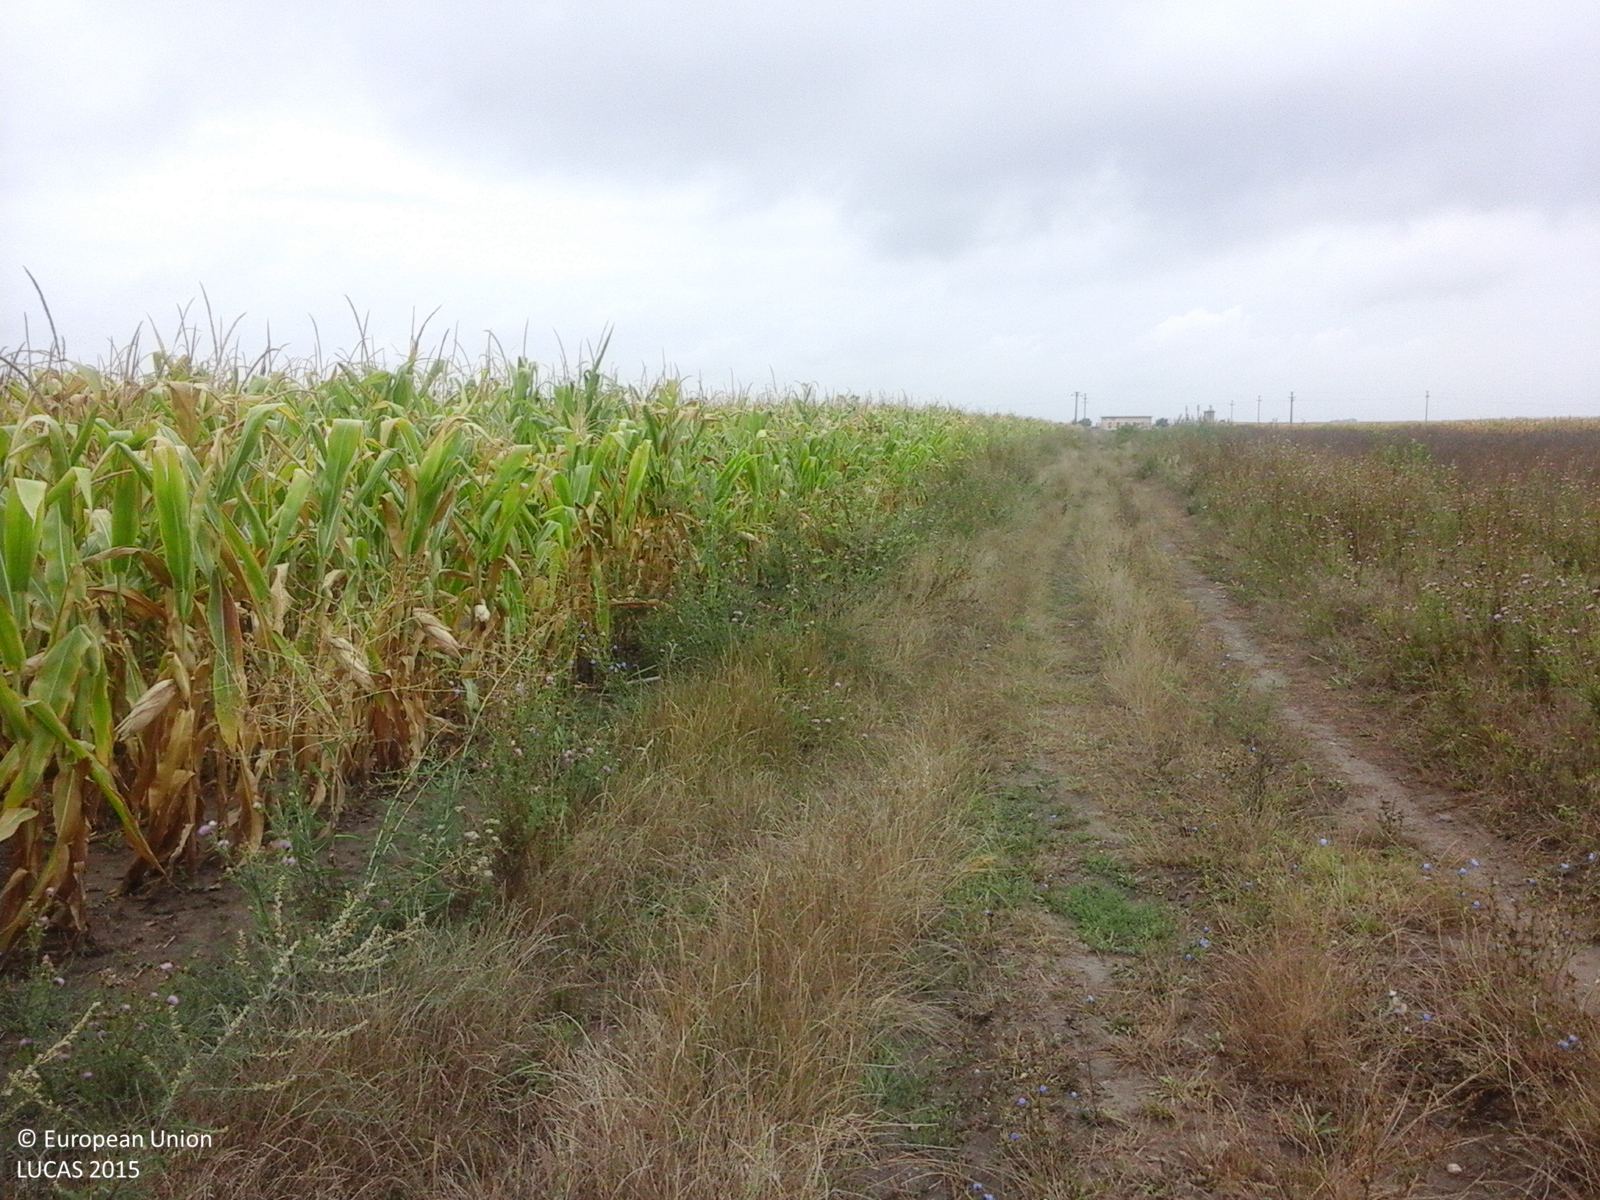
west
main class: Cropland
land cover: Maize
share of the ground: > 75 %
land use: Agriculture (excluding fallow land and kitchen gardens)
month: August
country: RO
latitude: 45.8288
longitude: 20.7228
